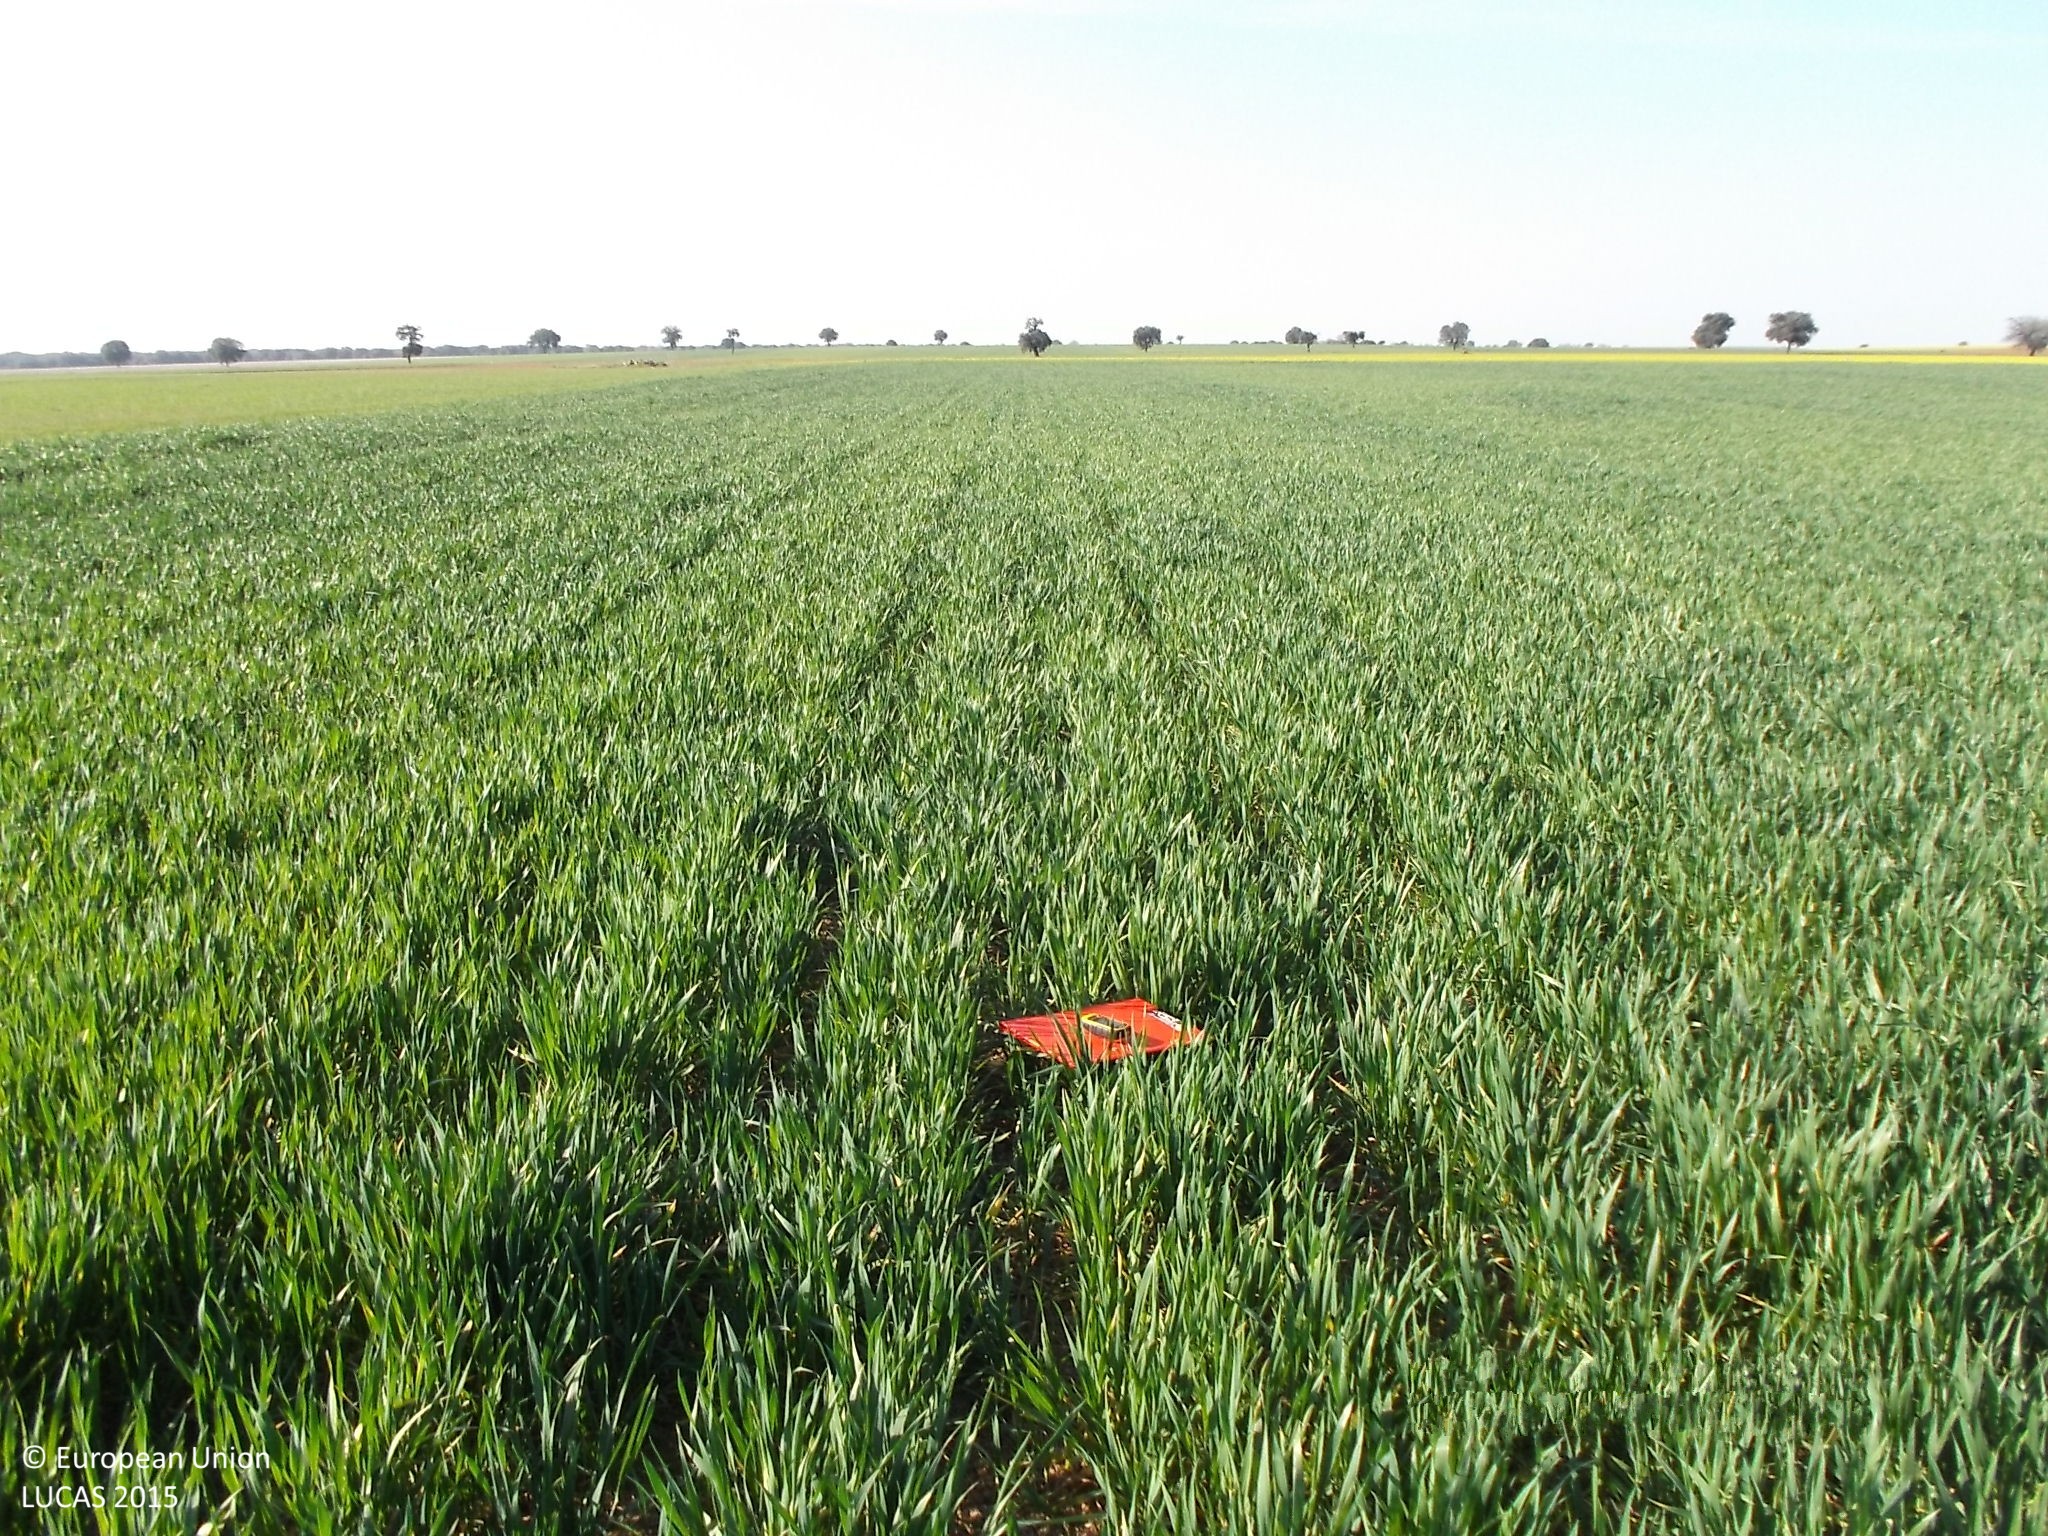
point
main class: Cropland
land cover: Common wheat
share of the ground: > 75 %
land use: Agriculture (excluding fallow land and kitchen gardens)
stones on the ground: 10 - 25 %
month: April
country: ES
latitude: 40.8921
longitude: -5.9025
